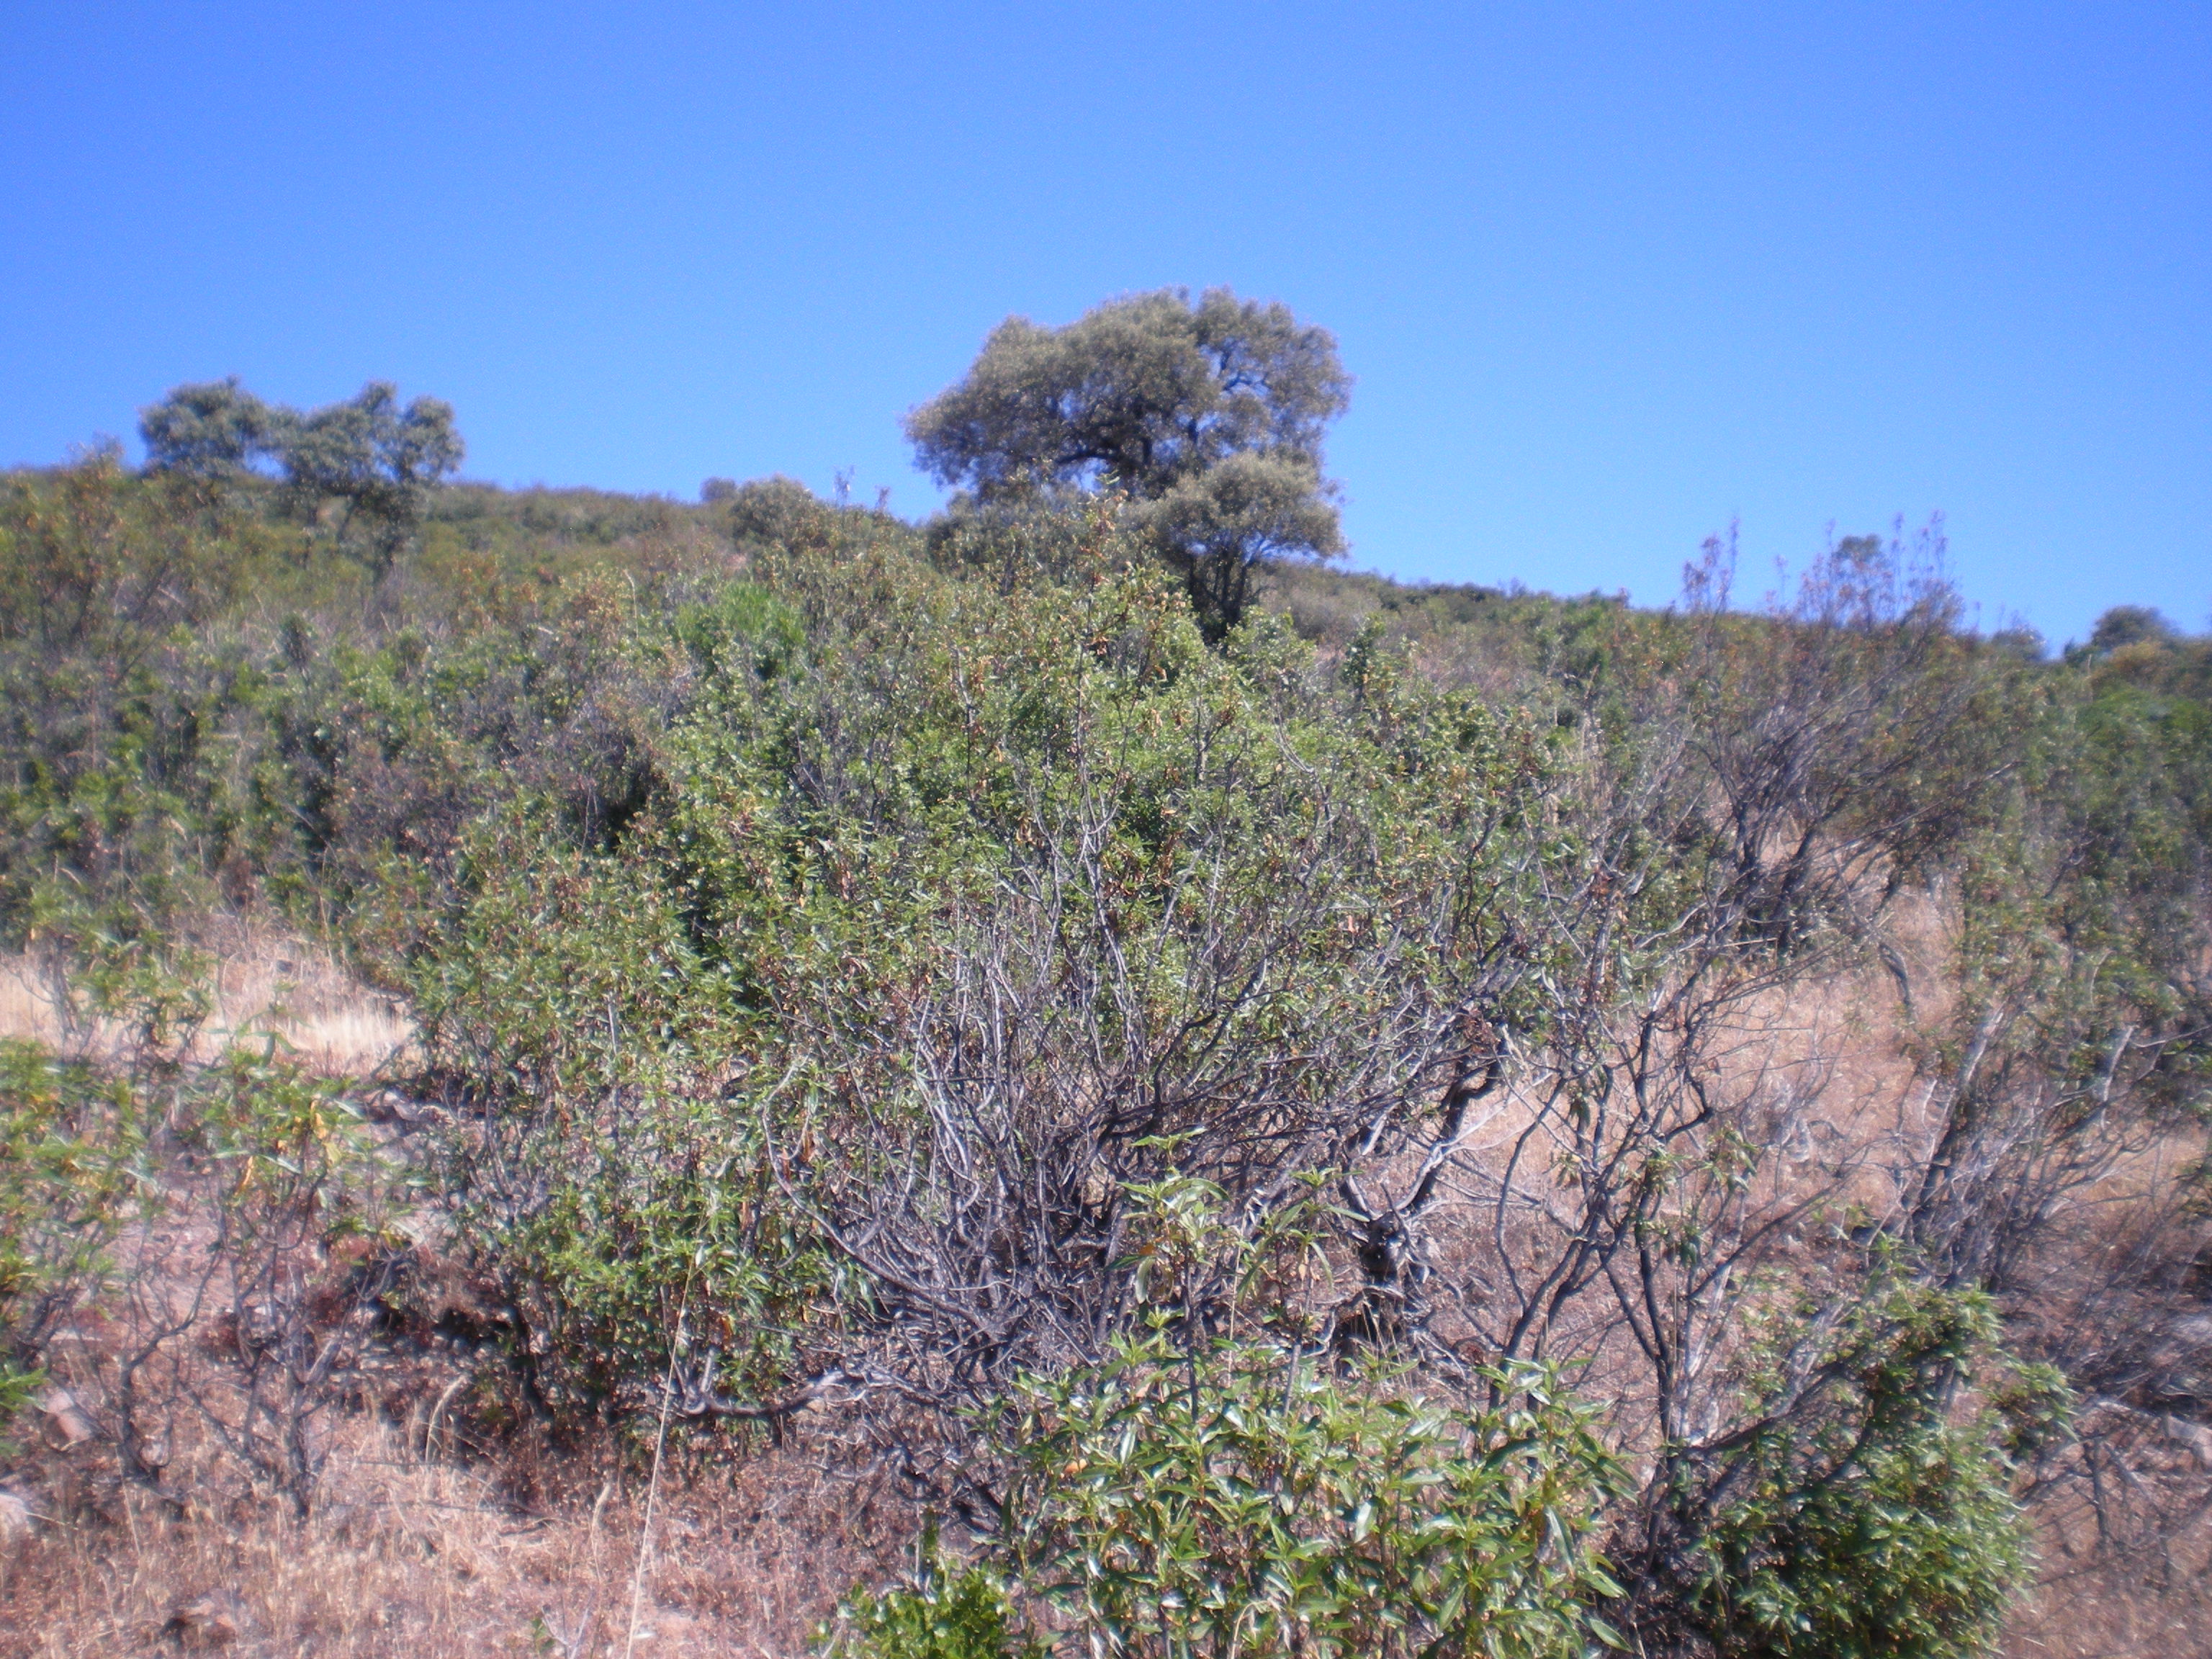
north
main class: Grassland
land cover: Grassland without tree/shrub cover
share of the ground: 10 - 25 %
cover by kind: unconsolidated bare surface 80 %, herbaceous plants 20 %
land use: Semi-natural and natural areas not in use
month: May
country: ES
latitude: 38.4455
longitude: -3.4007
